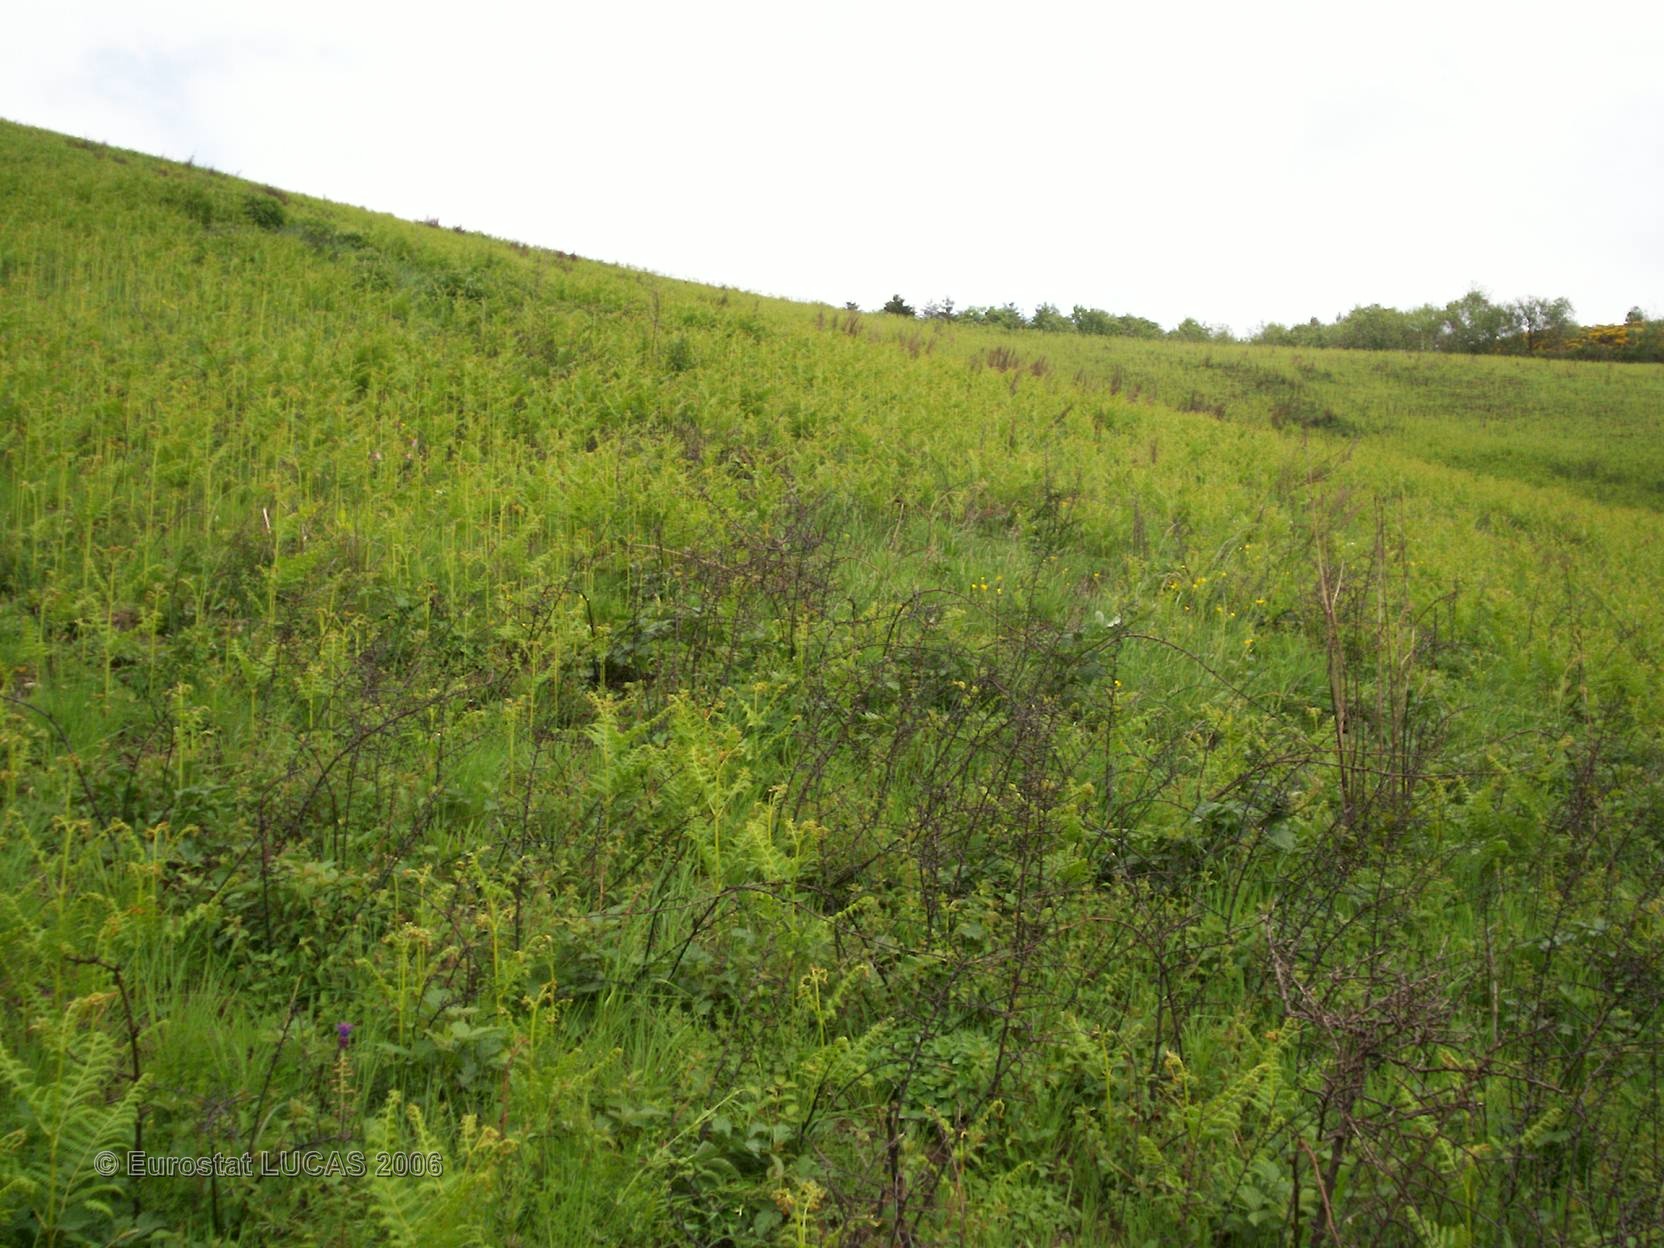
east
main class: Grassland
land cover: Grassland with sparse tree/shrub cover
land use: Agriculture (excluding fallow land and kitchen gardens)
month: May
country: FR
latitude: 43.9767
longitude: 3.3876
